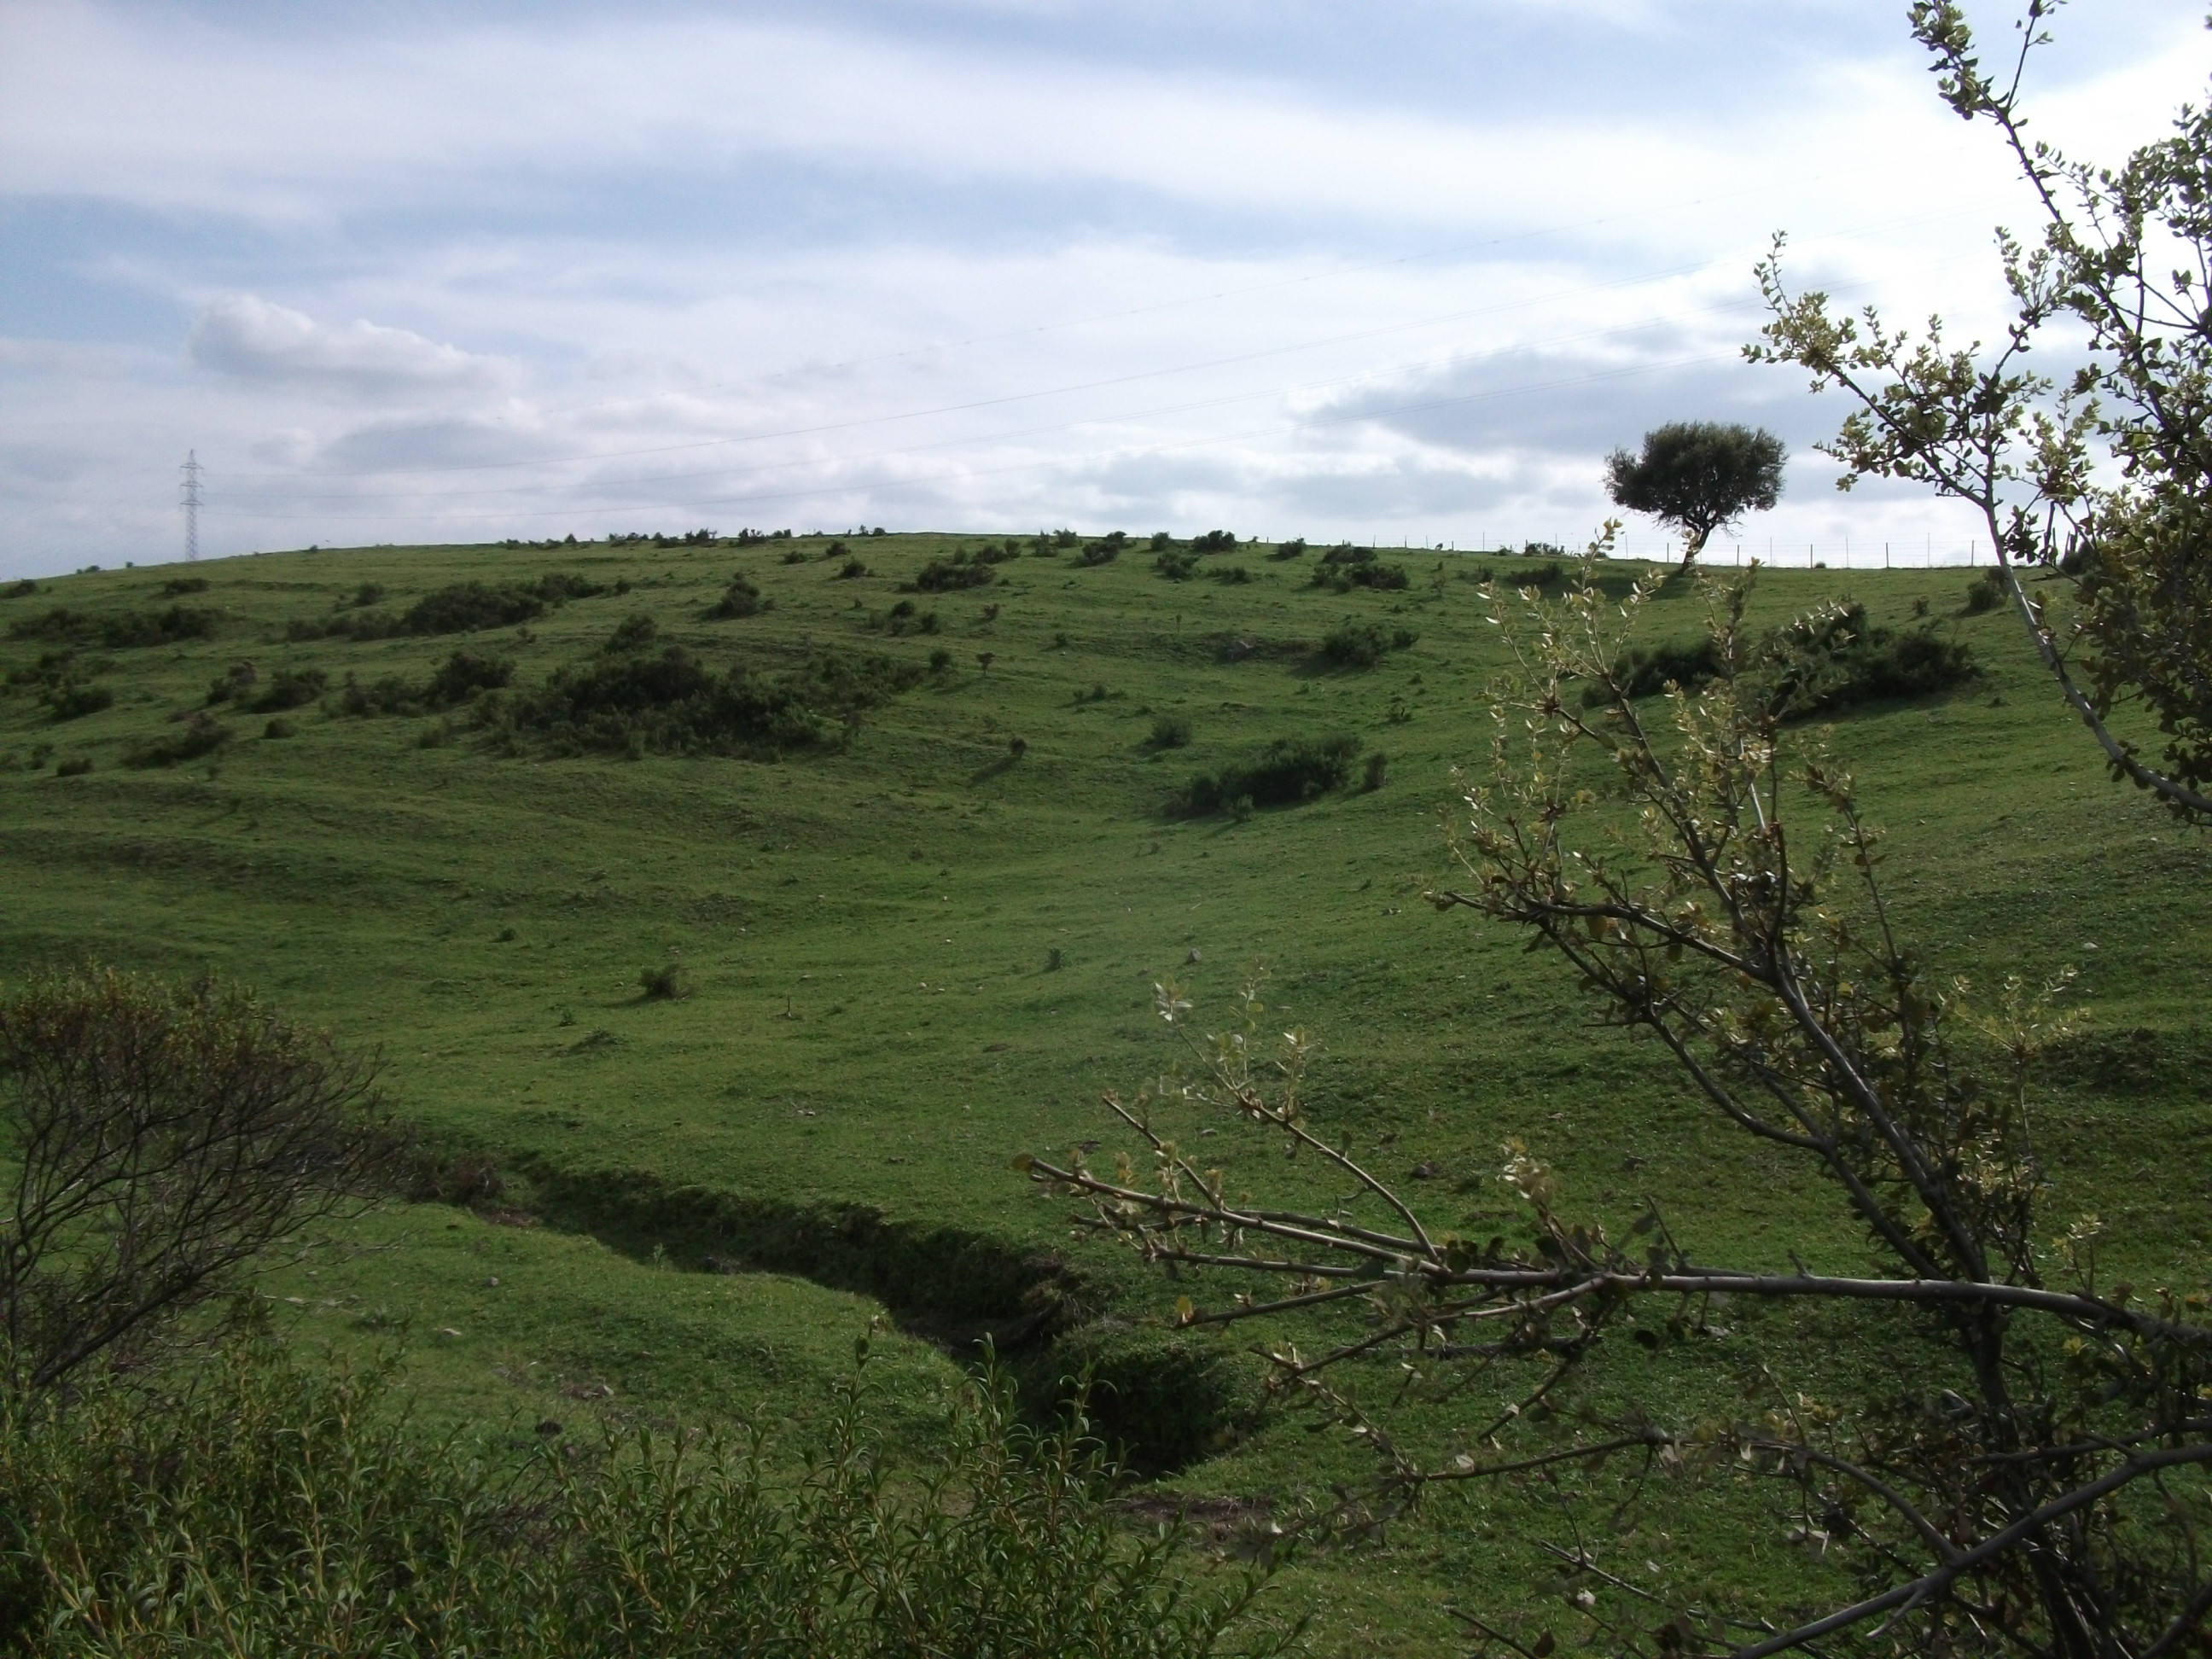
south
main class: Woodland
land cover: Broadleaved woodland
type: broadleaved evergreen forest
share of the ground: 25 - 50 %
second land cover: Shrubland without tree cover
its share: 25 - 50 %
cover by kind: shrubs 40 %, broadleaved forest trees 30 %, herbaceous plants 30 %
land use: Forestry
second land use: Agriculture (excluding fallow land and kitchen gardens)
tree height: < 5 m
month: April
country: ES
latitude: 37.8834
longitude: -6.4942
